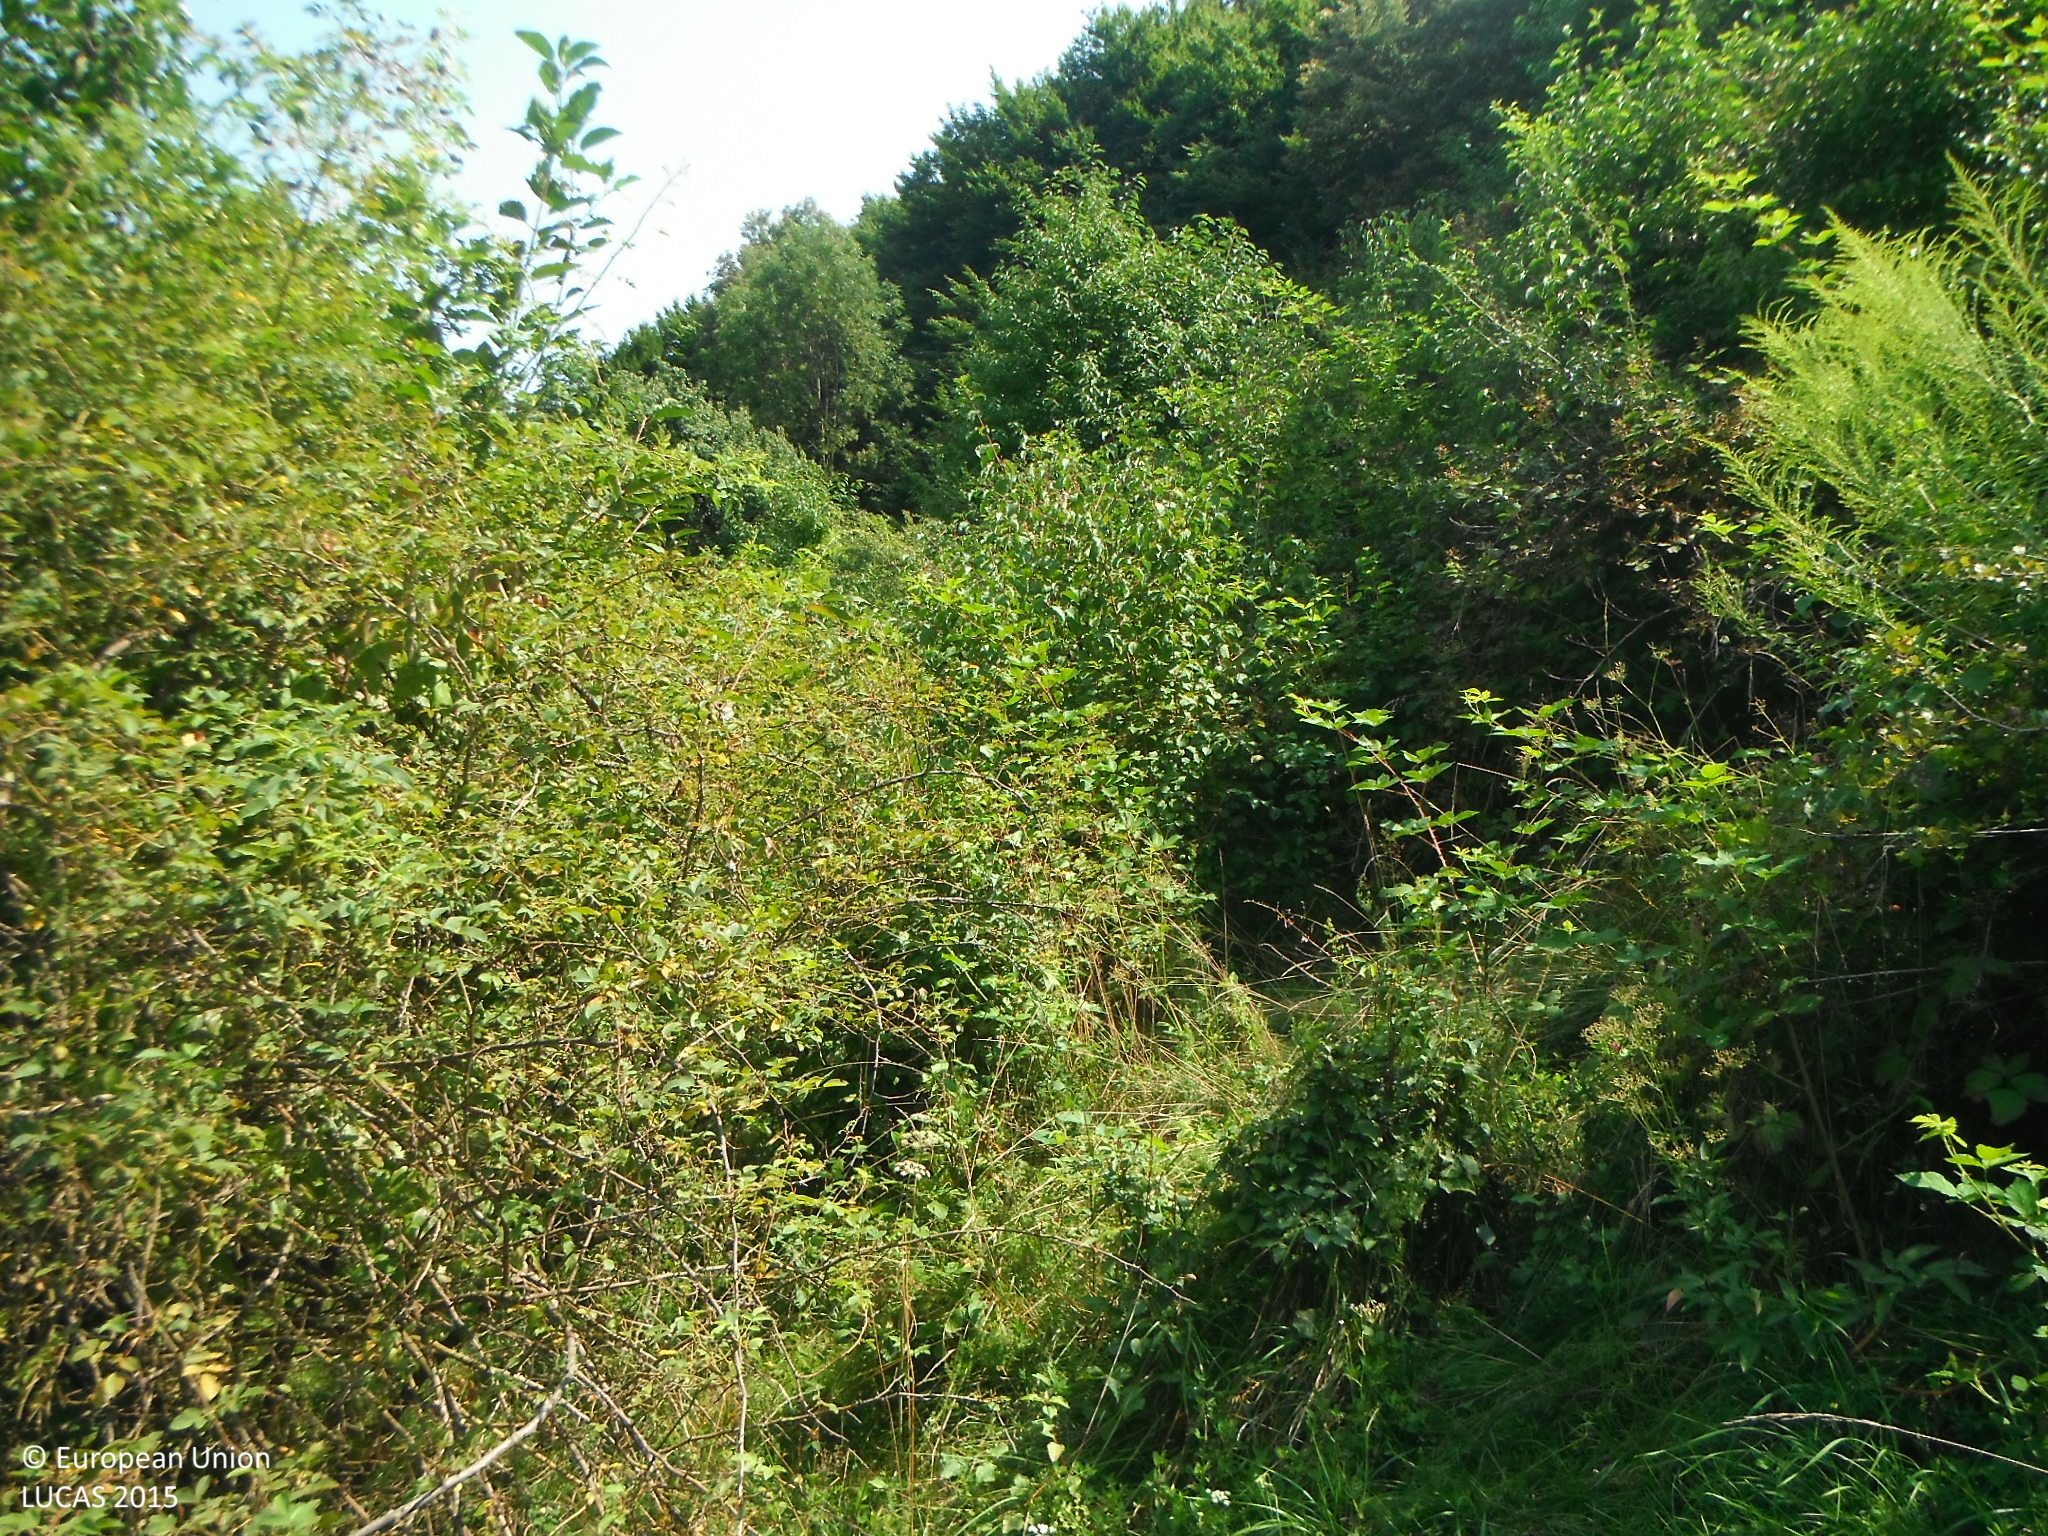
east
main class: Shrubland
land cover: Shrubland with sparse tree cover
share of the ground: > 75 %
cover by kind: shrubs 95 %, broadleaved forest trees 5 %
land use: Semi-natural and natural areas not in use
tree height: > 5 m
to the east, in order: Shrubland with sparse tree cover; Broadleaved woodland
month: August
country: SK
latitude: 48.6257
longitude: 20.5230
